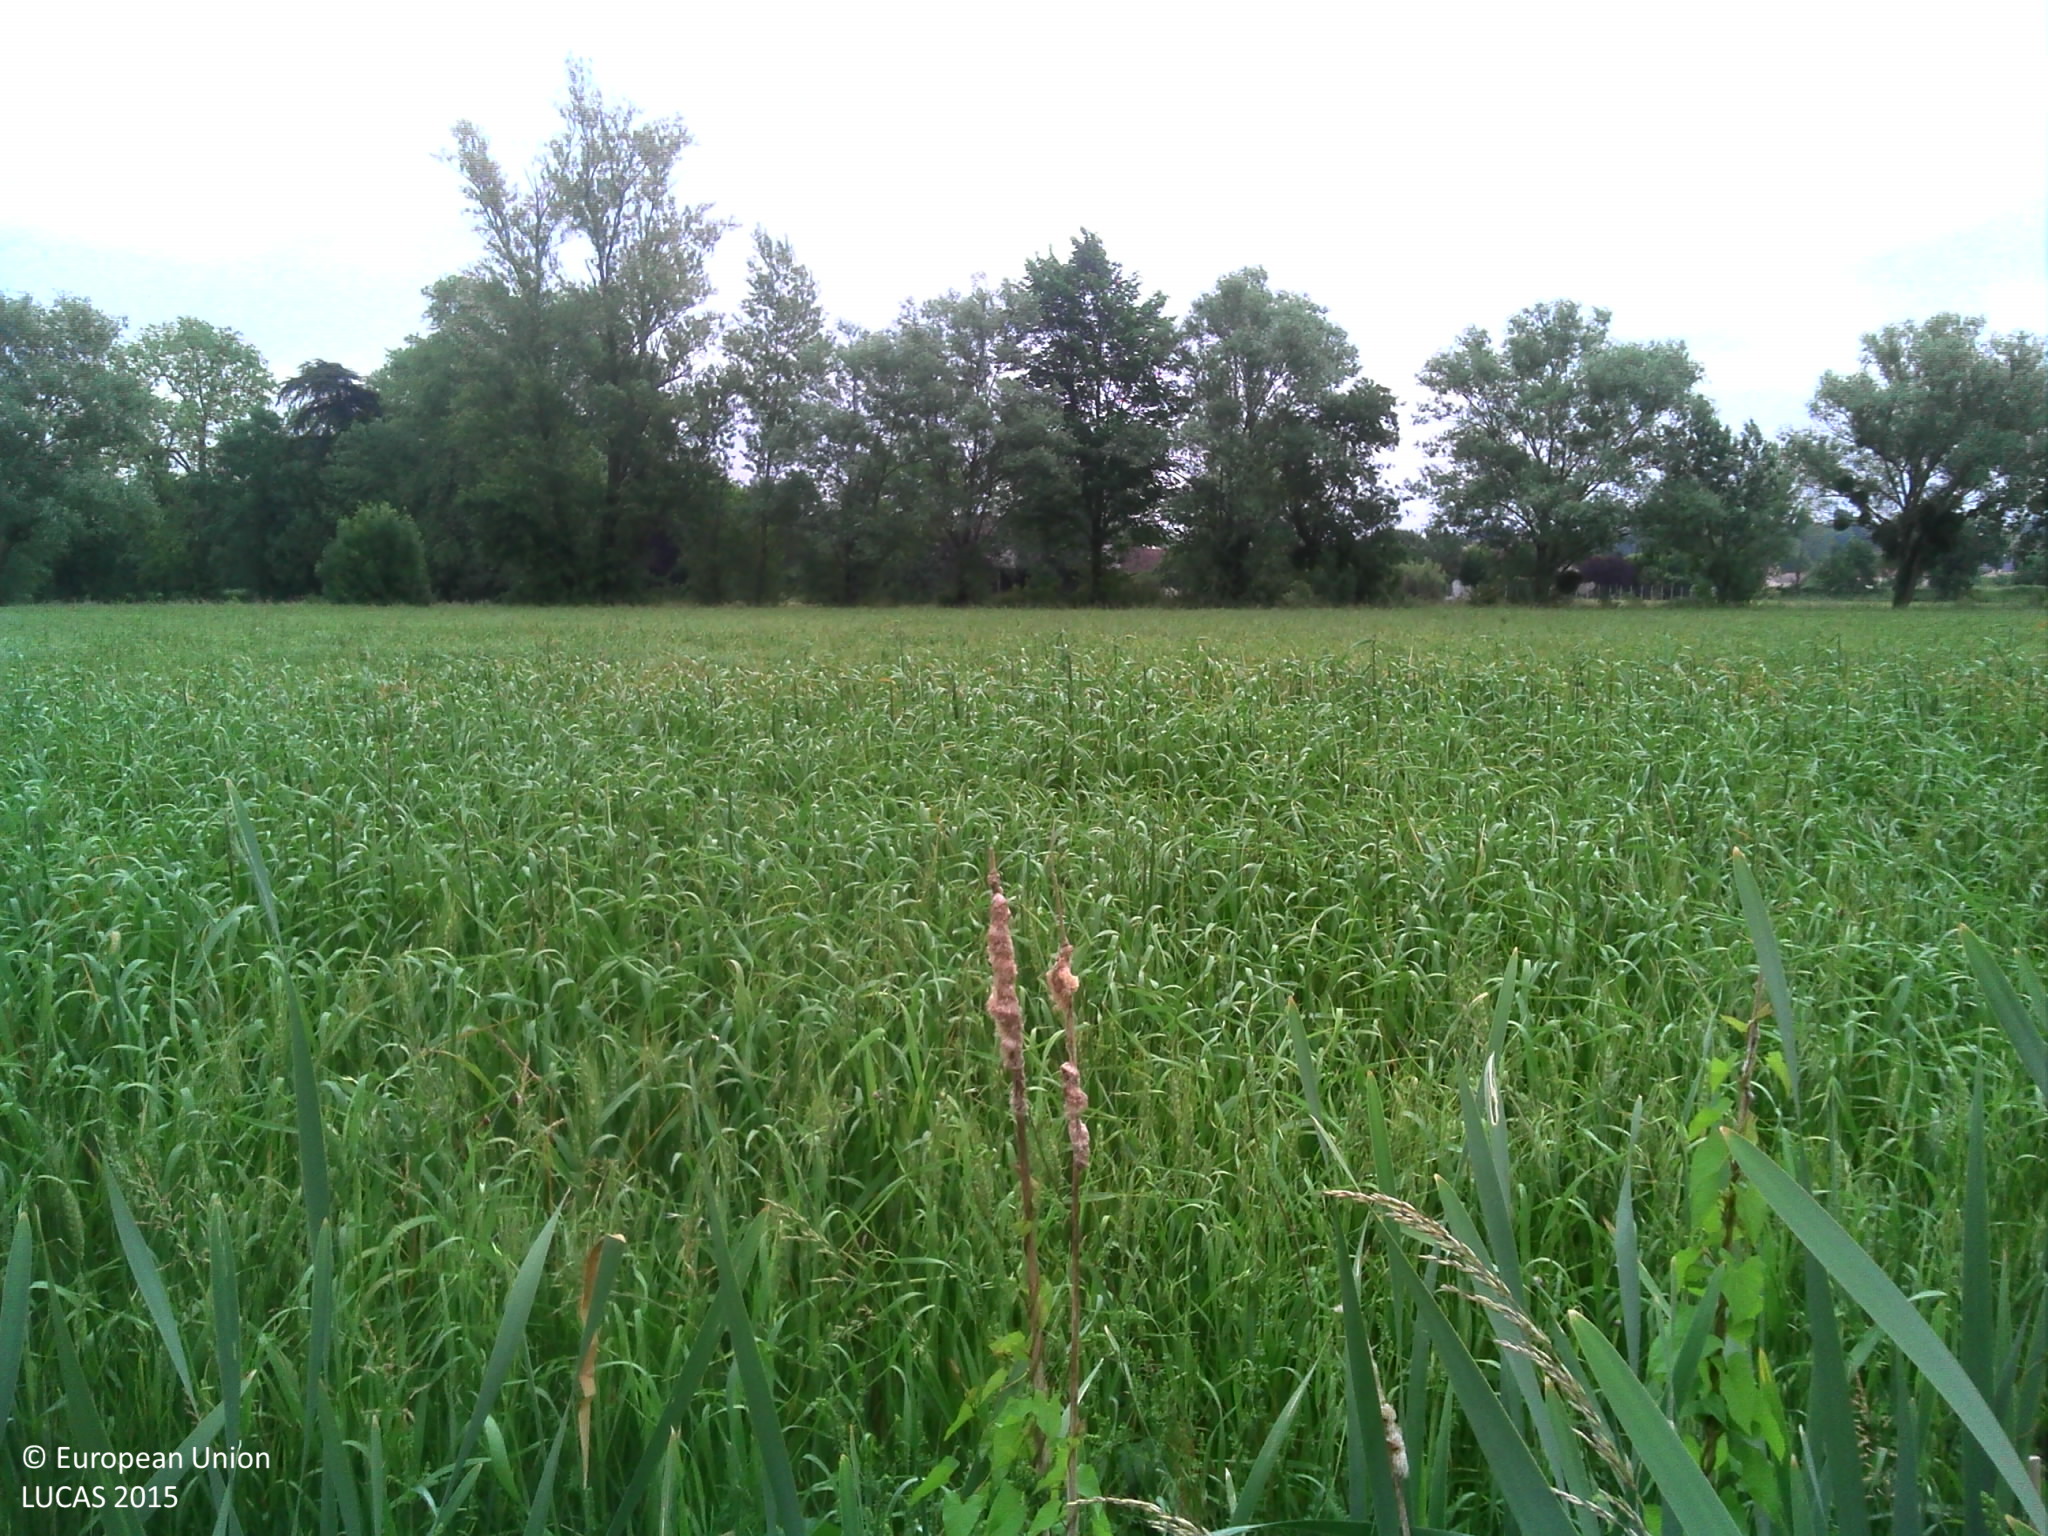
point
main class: Cropland
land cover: Common wheat
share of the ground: > 75 %
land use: Agriculture (excluding fallow land and kitchen gardens)
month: May
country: FR
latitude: 43.7670
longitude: 1.9667
